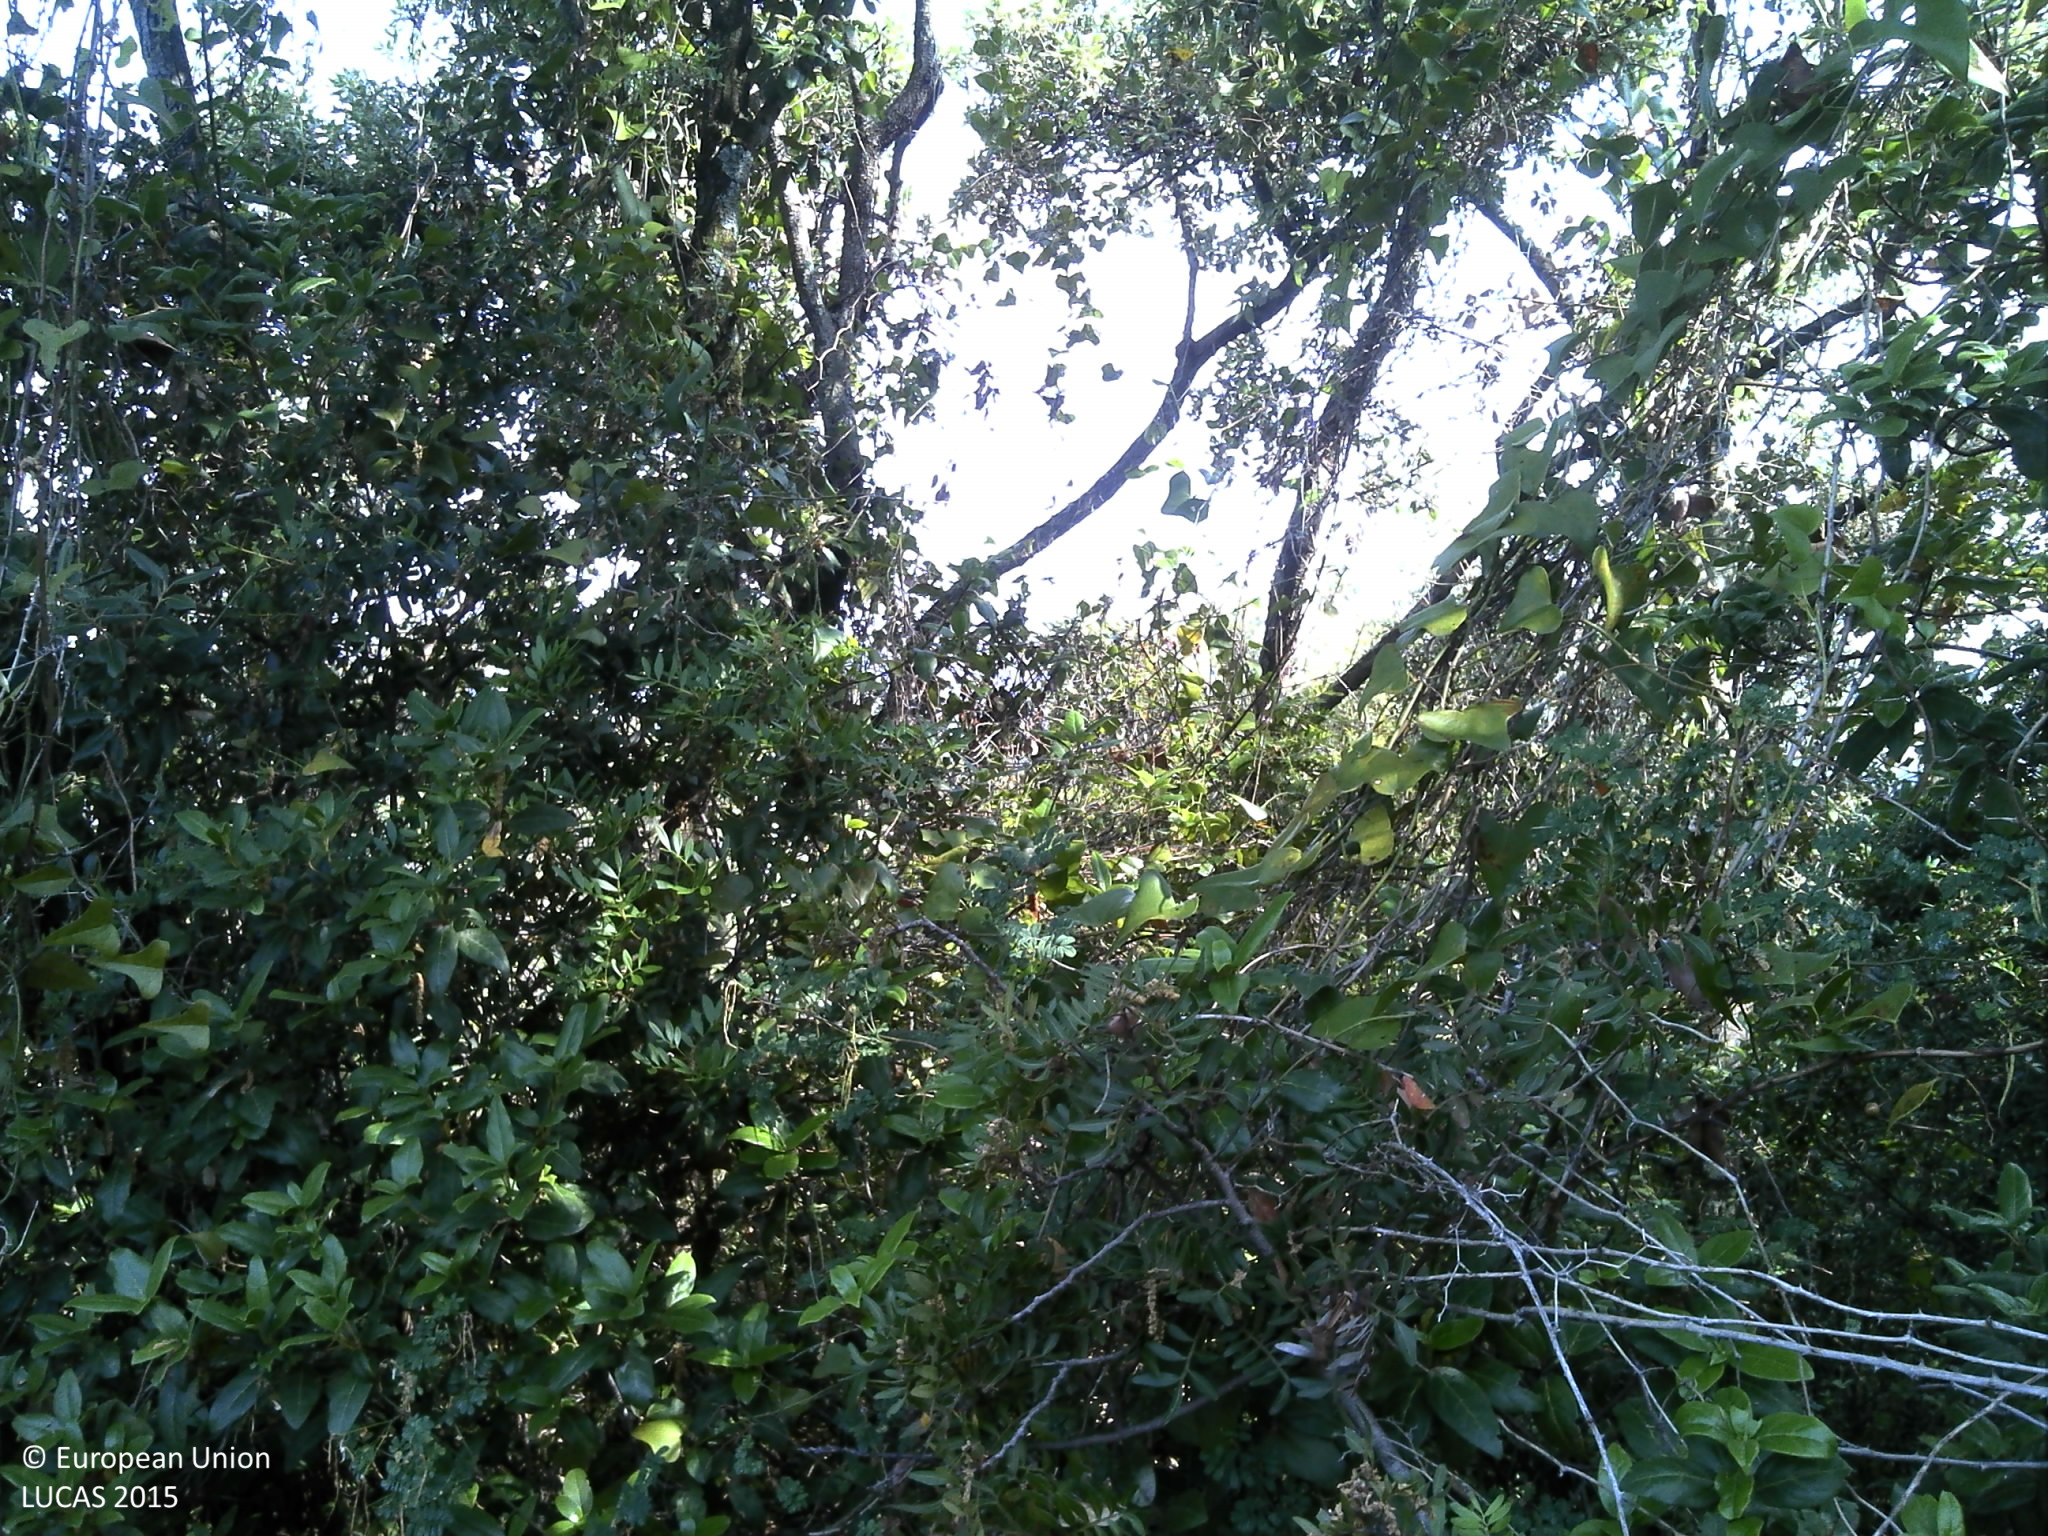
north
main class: Woodland
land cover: Broadleaved woodland
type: thermophilous deciduous forest
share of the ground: 25 - 50 %
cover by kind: broadleaved forest trees 40 %, shrubs 30 %, consolidated bare surface 20 %, unconsolidated bare surface 10 %
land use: Semi-natural and natural areas not in use
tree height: > 5 m
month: June
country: HR
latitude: 43.4952
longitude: 16.2108
